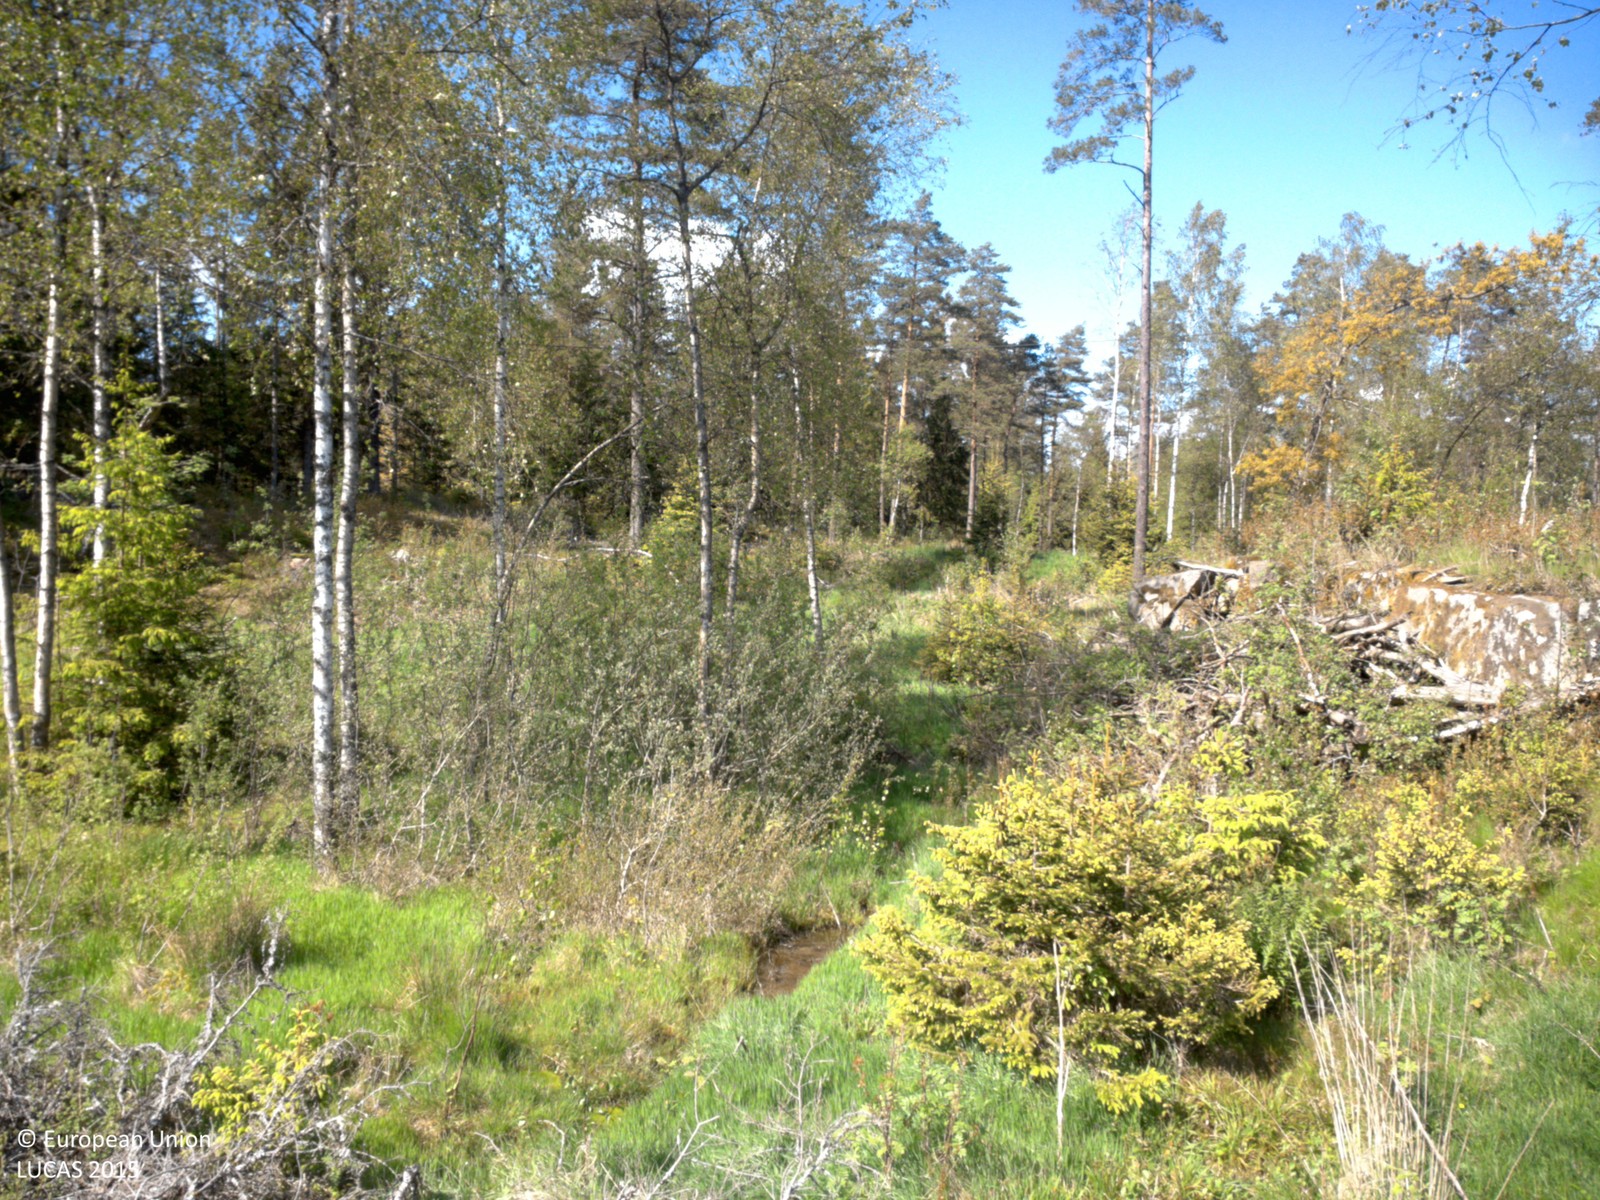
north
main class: Grassland
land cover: Grassland with sparse tree/shrub cover
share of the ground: > 75 %
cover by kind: herbaceous plants 70 %, coniferous forest trees 5 %
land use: Forestry
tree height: > 5 m
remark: Clear cut
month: June
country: SE
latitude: 58.3856
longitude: 11.9288
